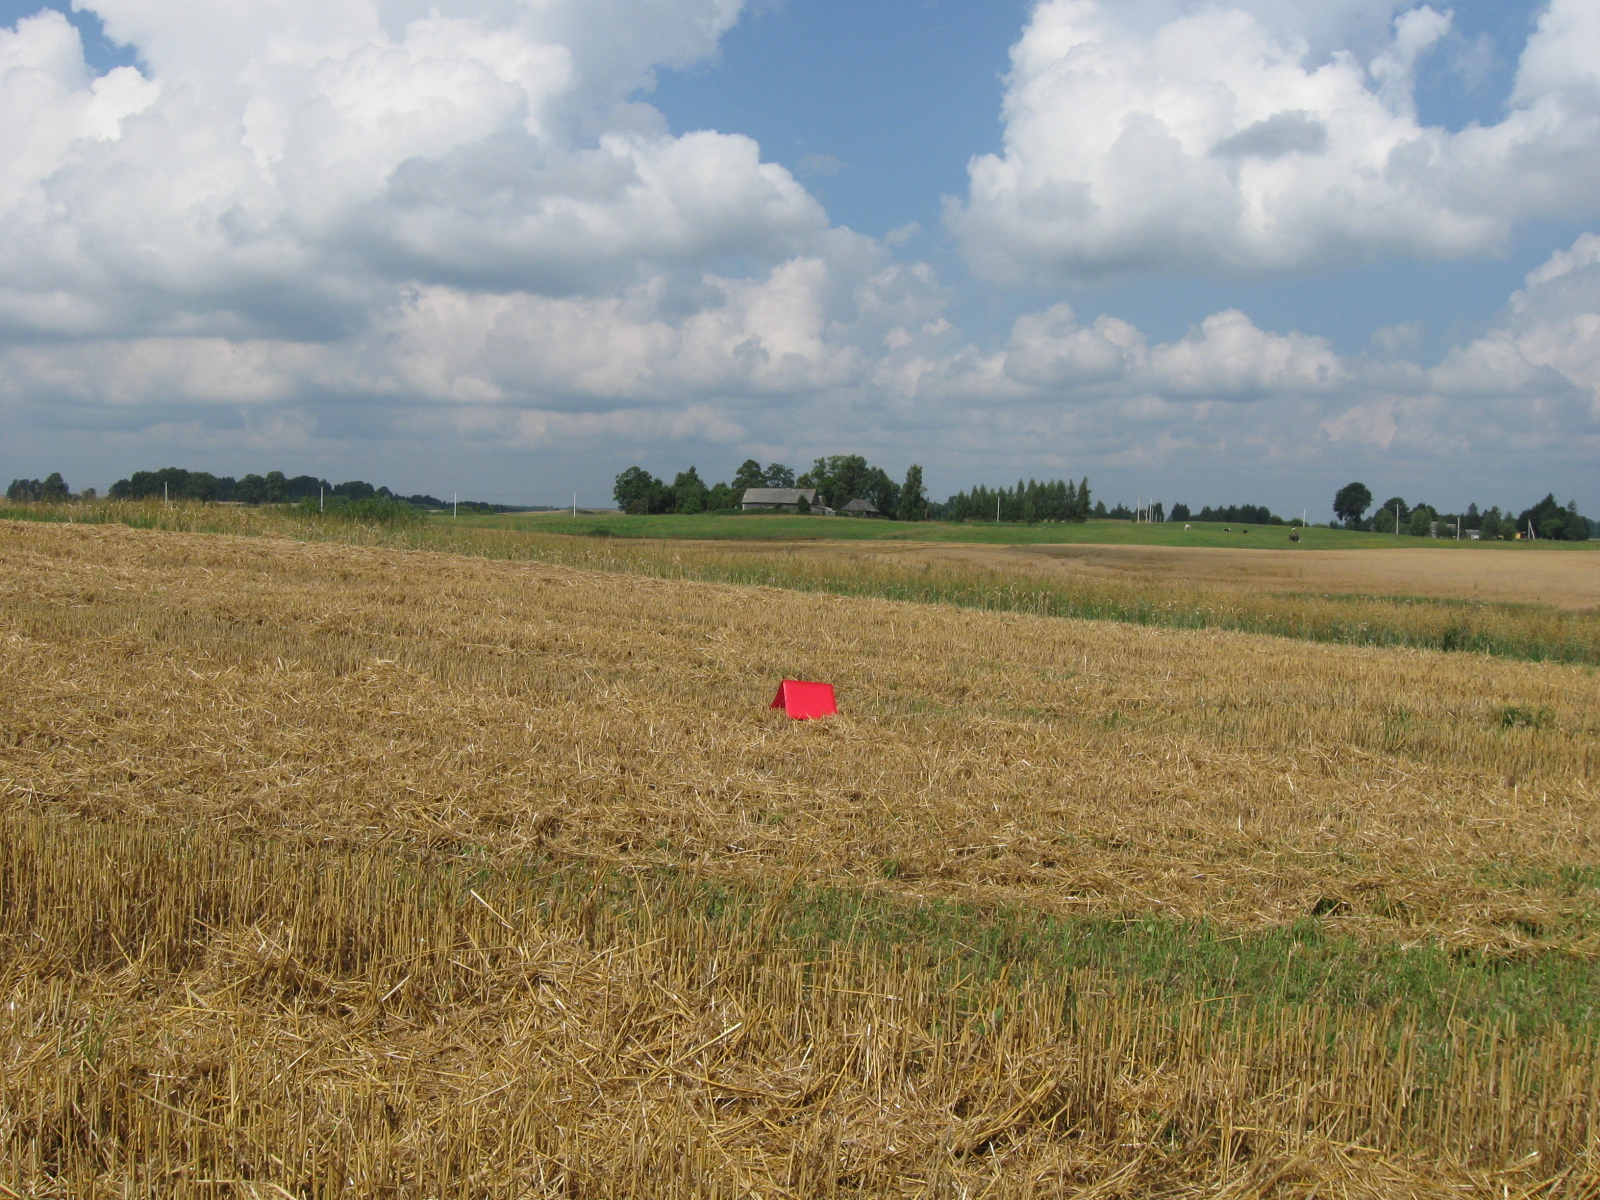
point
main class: Cropland
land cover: Common wheat
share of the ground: > 75 %
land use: Agriculture (excluding fallow land and kitchen gardens)
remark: Harvested field
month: August
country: LT
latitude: 54.7034
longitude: 23.6635
